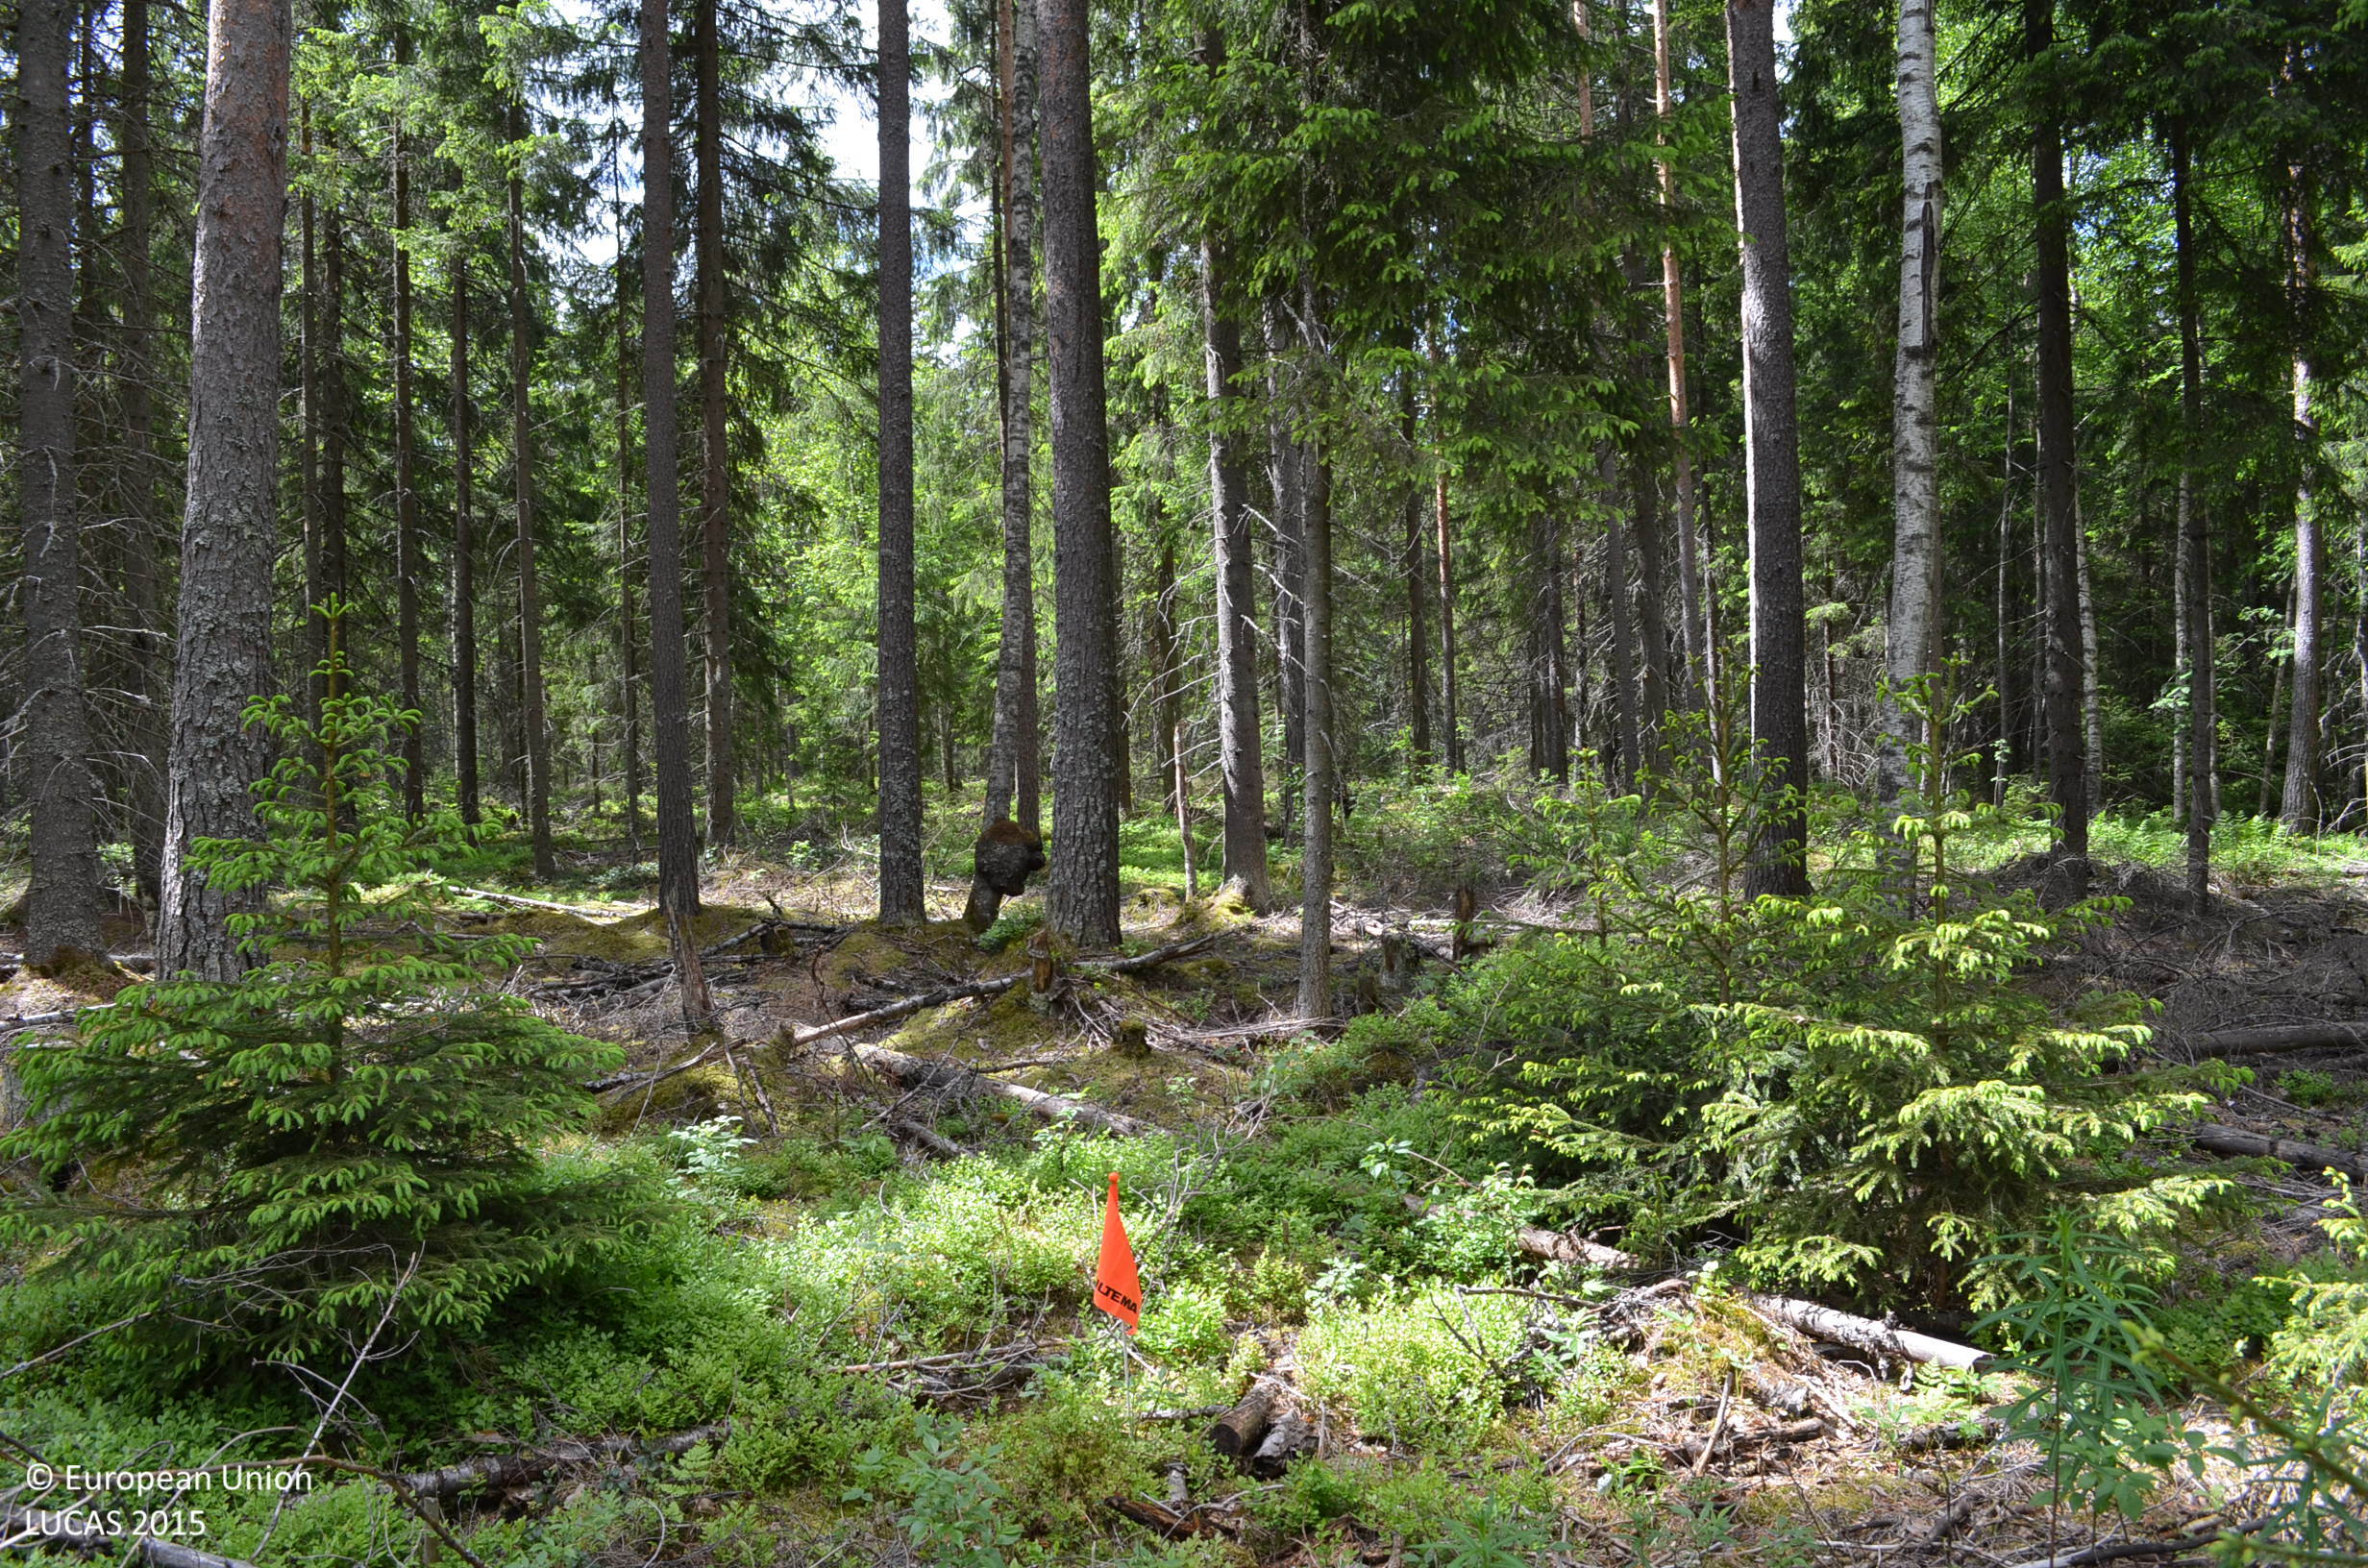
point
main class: Woodland
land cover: Other mixed woodland
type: boreal forest
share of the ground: > 75 %
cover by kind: coniferous forest trees 60 %, broadleaved forest trees 20 %, shrubs 20 %
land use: Forestry
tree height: > 5 m
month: June
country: FI
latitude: 61.9759
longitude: 23.3712
